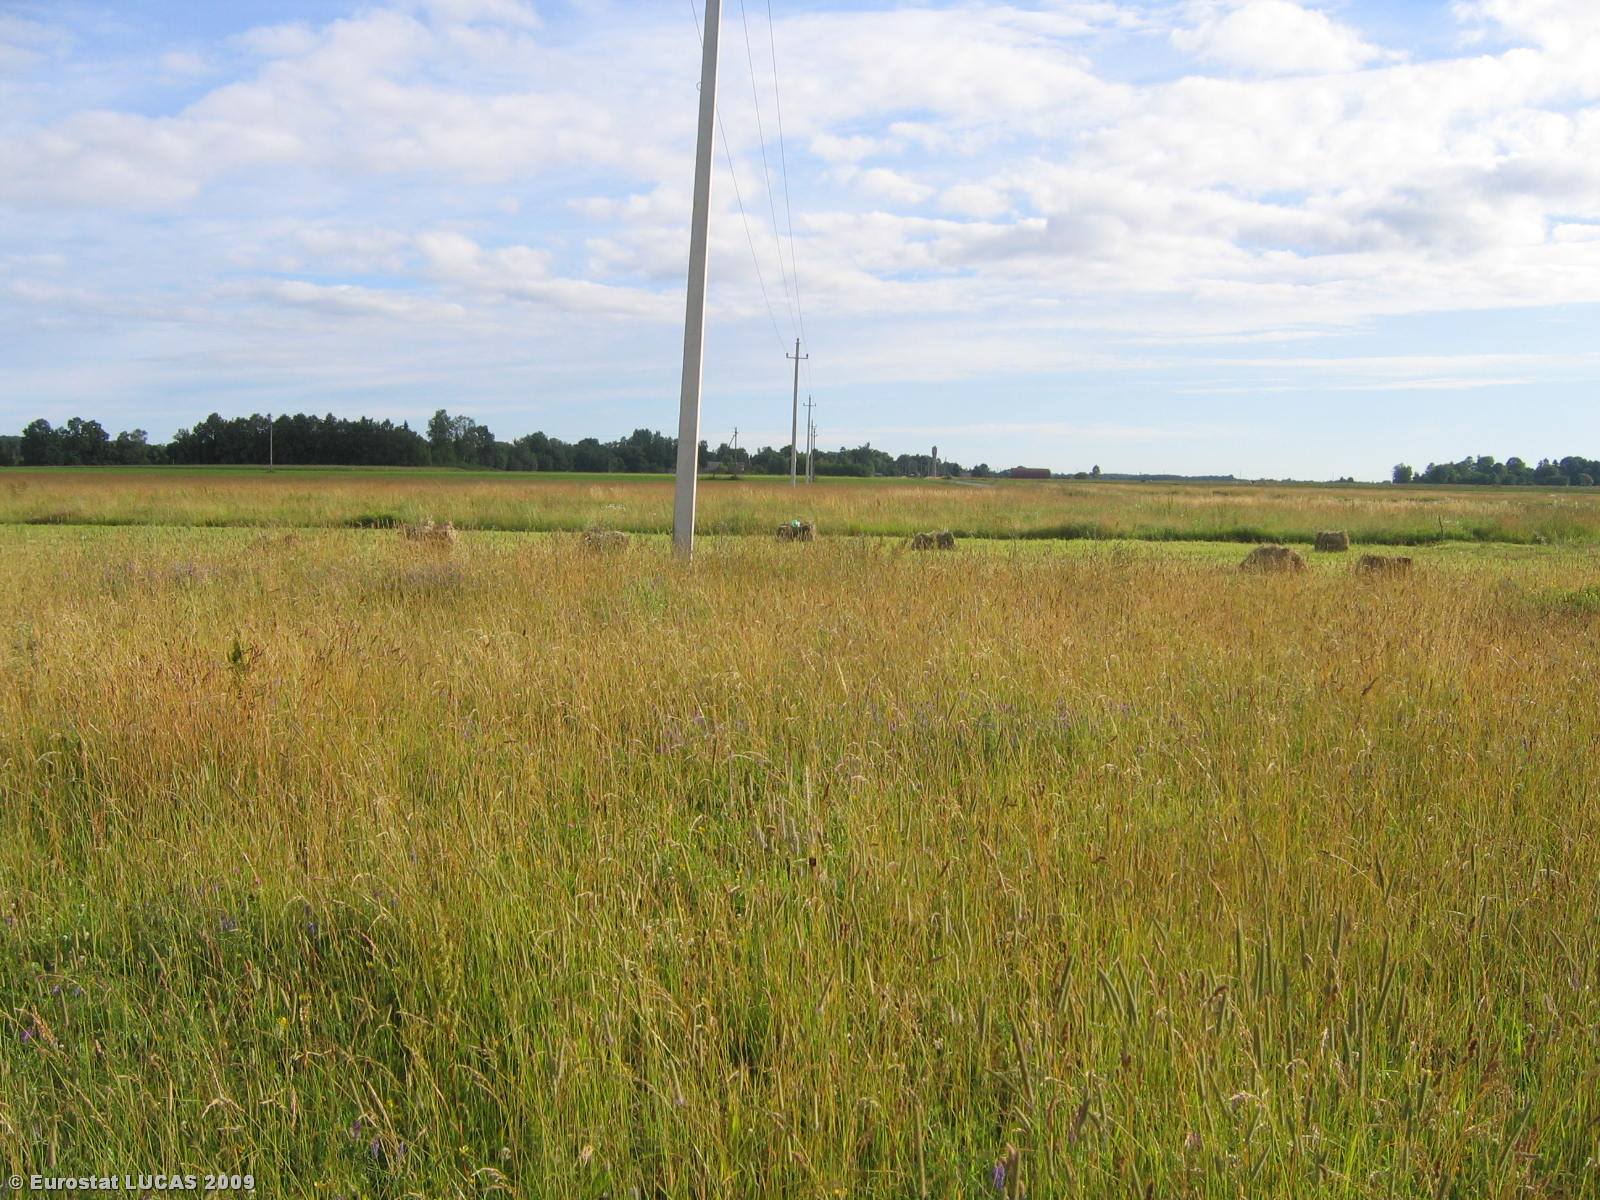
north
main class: Grassland
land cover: Grassland without tree/shrub cover
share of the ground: > 75 %
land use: Agriculture (excluding fallow land and kitchen gardens)
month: July
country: LT
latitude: 55.3677
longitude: 22.7350
